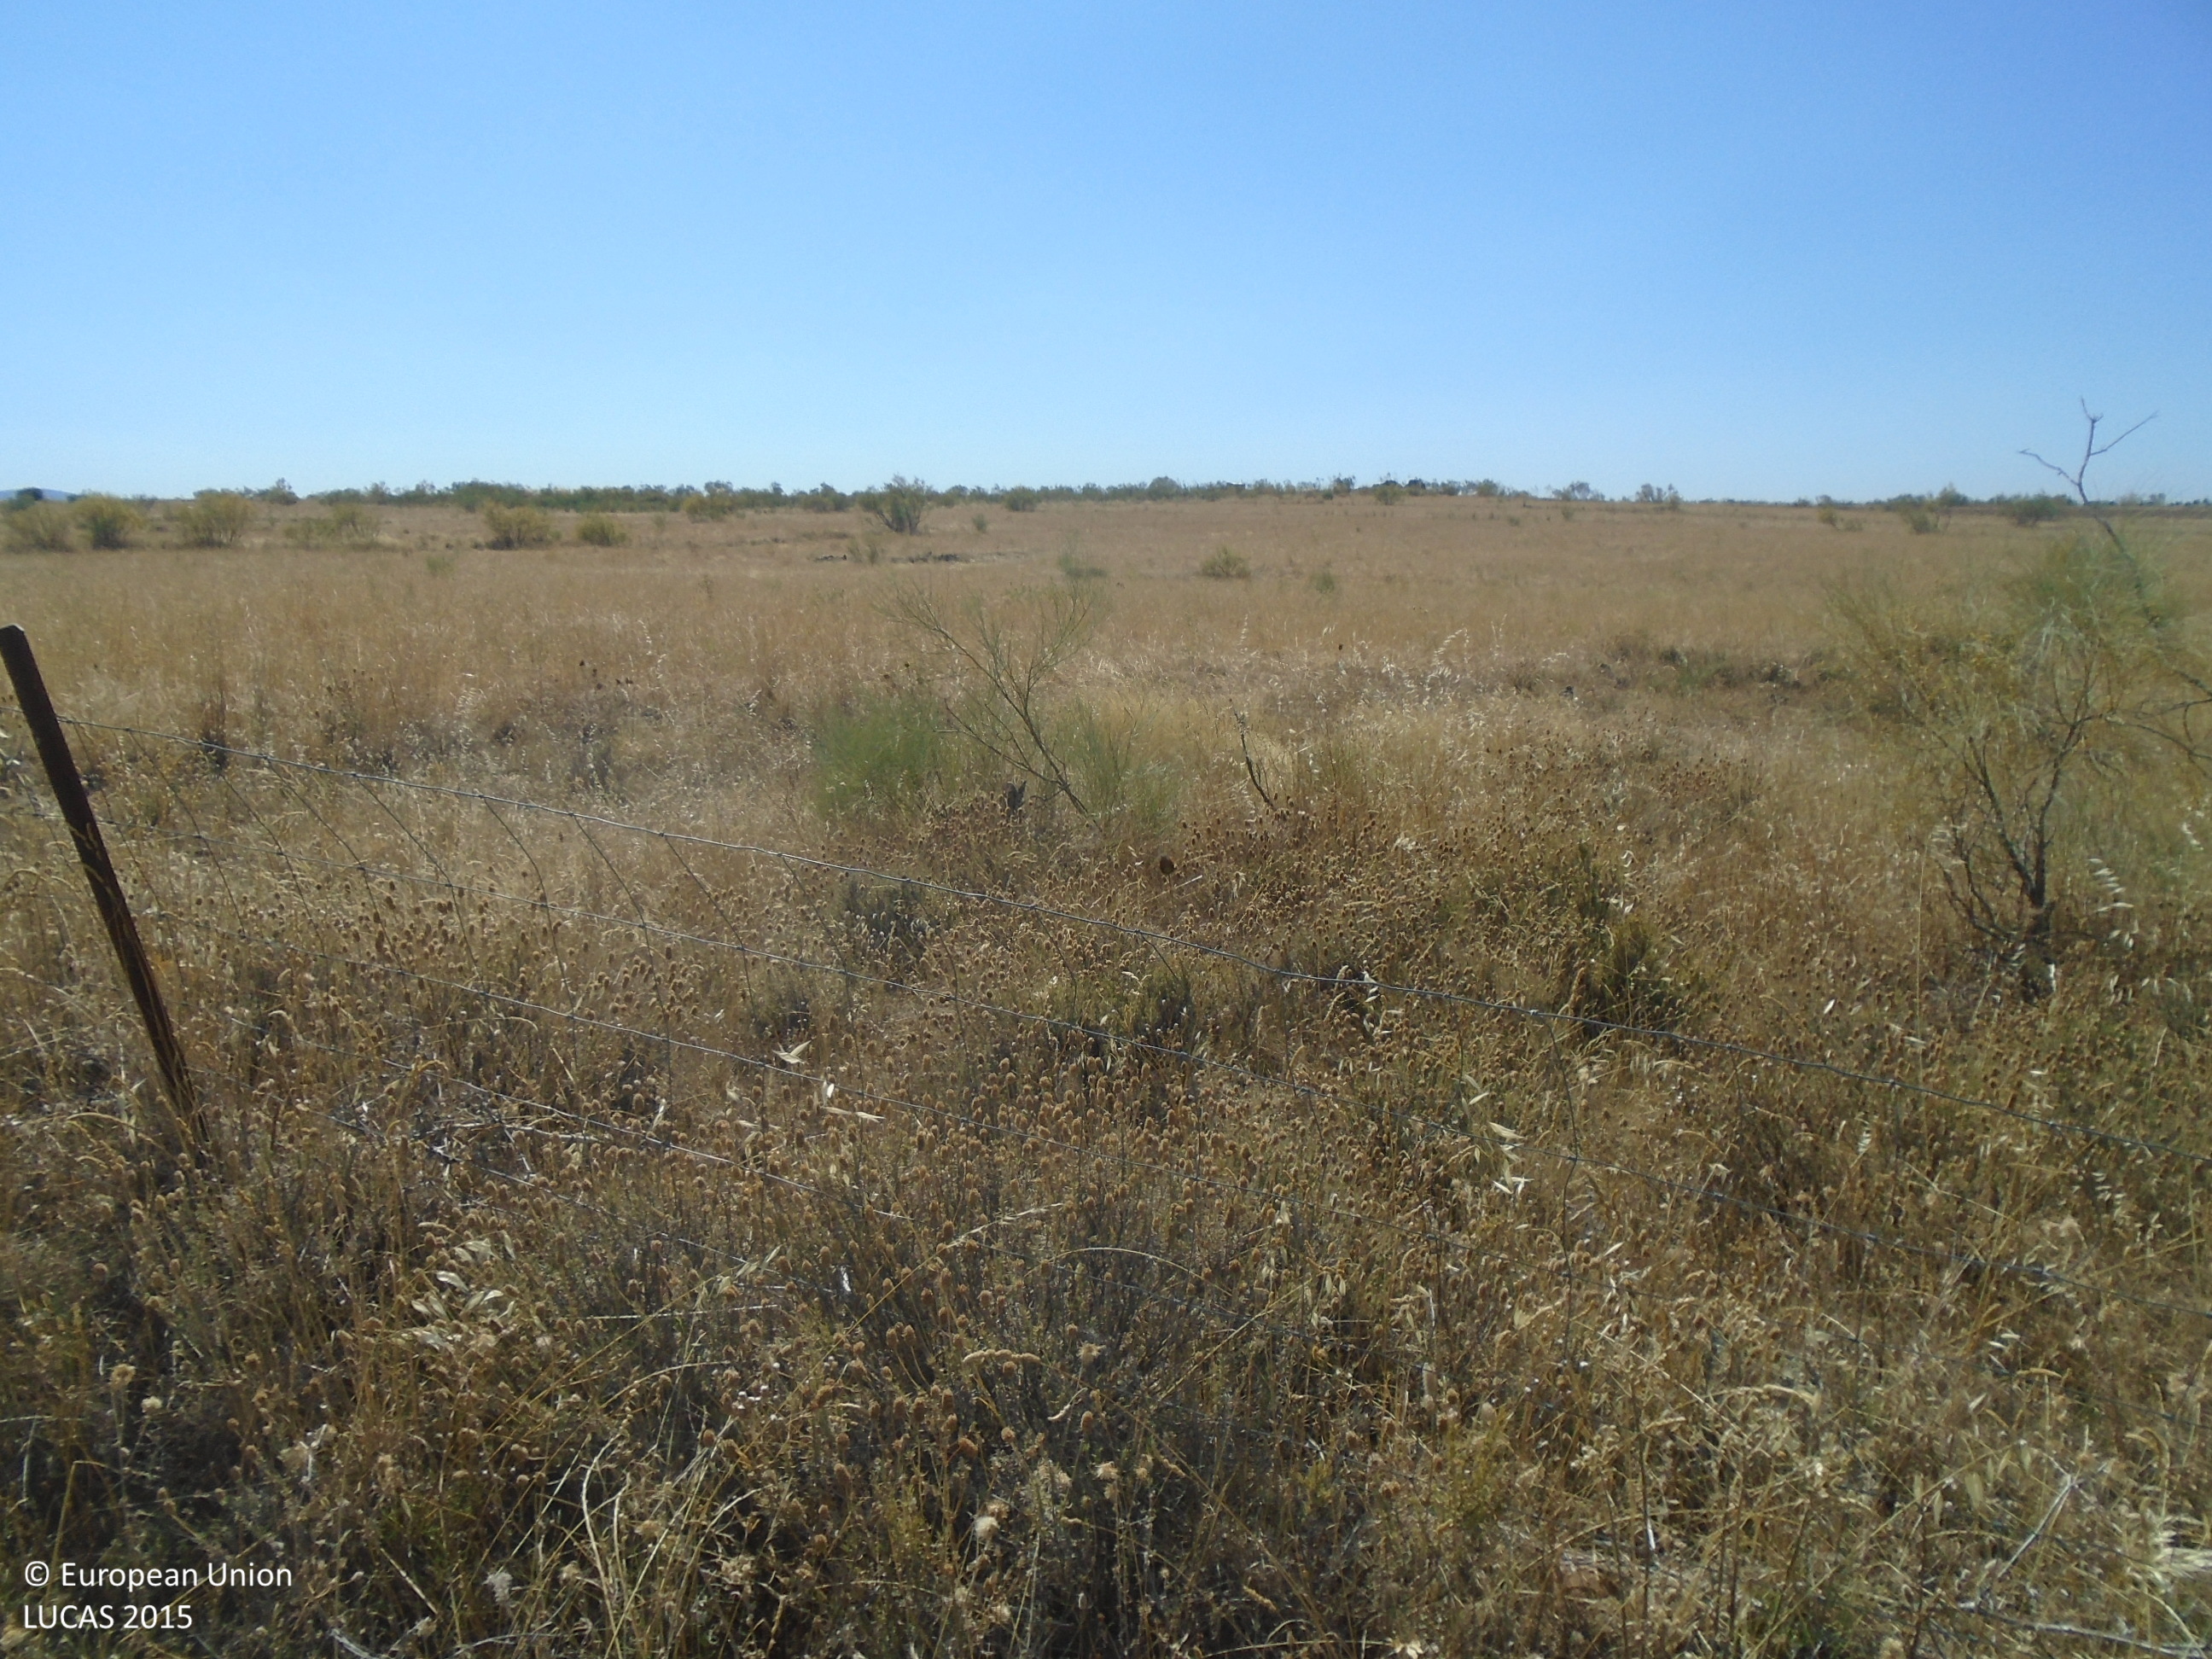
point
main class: Grassland
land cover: Spontaneously vegetated surfaces
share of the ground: > 75 %
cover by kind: herbaceous plants 100 %
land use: Abandoned areas
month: July
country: ES
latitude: 39.6649
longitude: -5.0725
